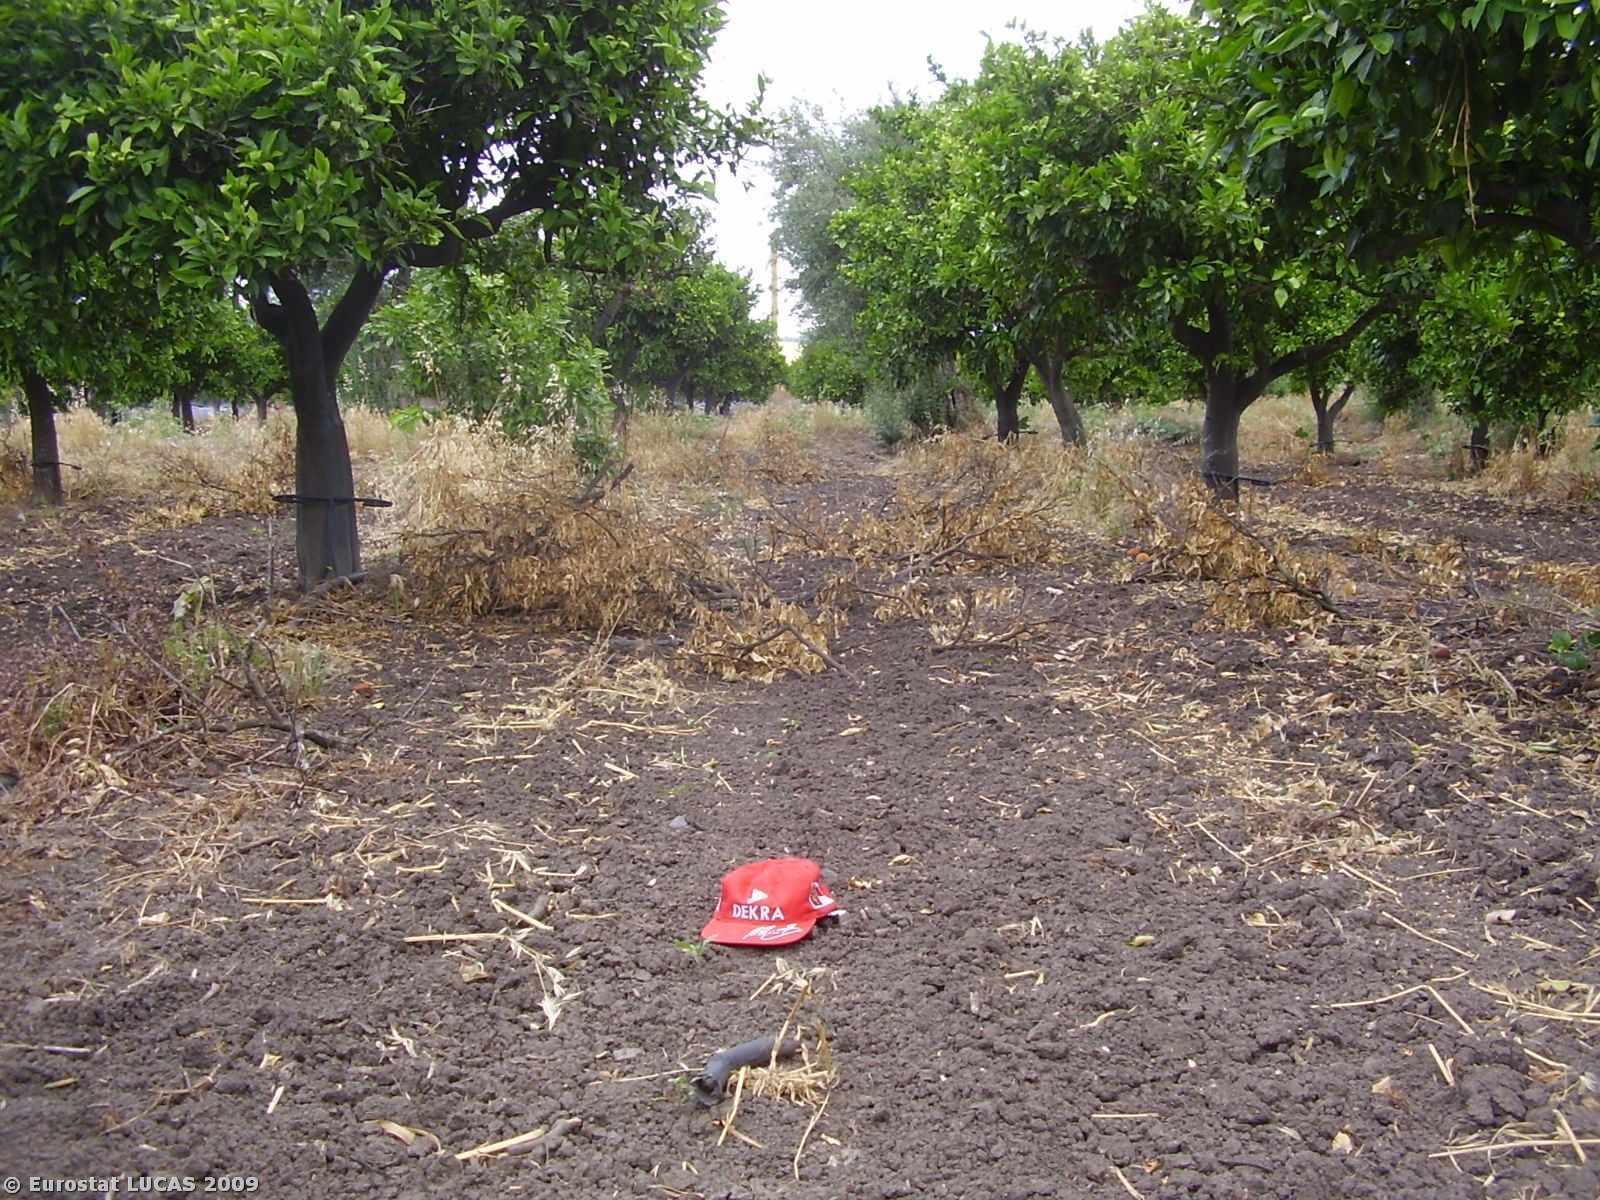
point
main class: Cropland
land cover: Oranges
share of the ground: 50 - 75 %
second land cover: Bare land
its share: > 75 %
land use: Agriculture (excluding fallow land and kitchen gardens)
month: June
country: IT
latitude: 37.2930
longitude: 14.9154
